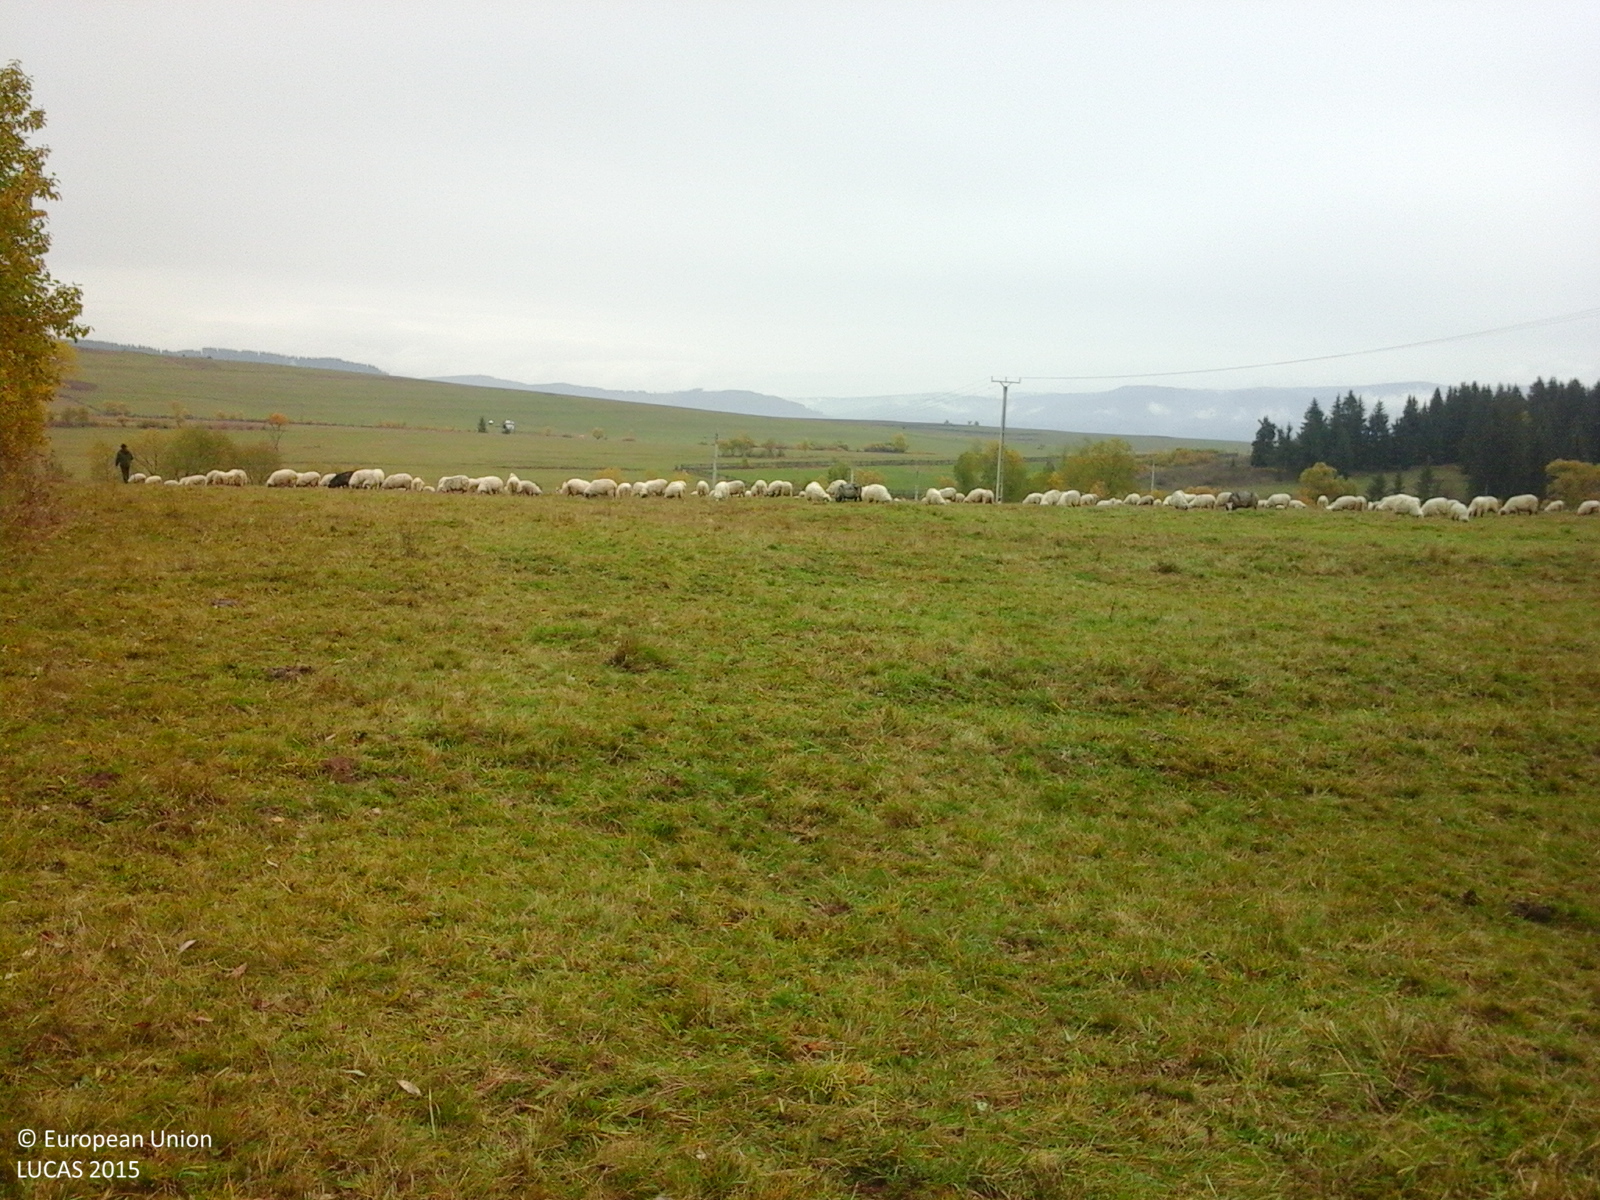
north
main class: Grassland
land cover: Grassland without tree/shrub cover
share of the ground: > 75 %
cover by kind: herbaceous plants 100 %
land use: Agriculture (excluding fallow land and kitchen gardens)
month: October
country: RO
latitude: 46.9059
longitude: 25.3232
